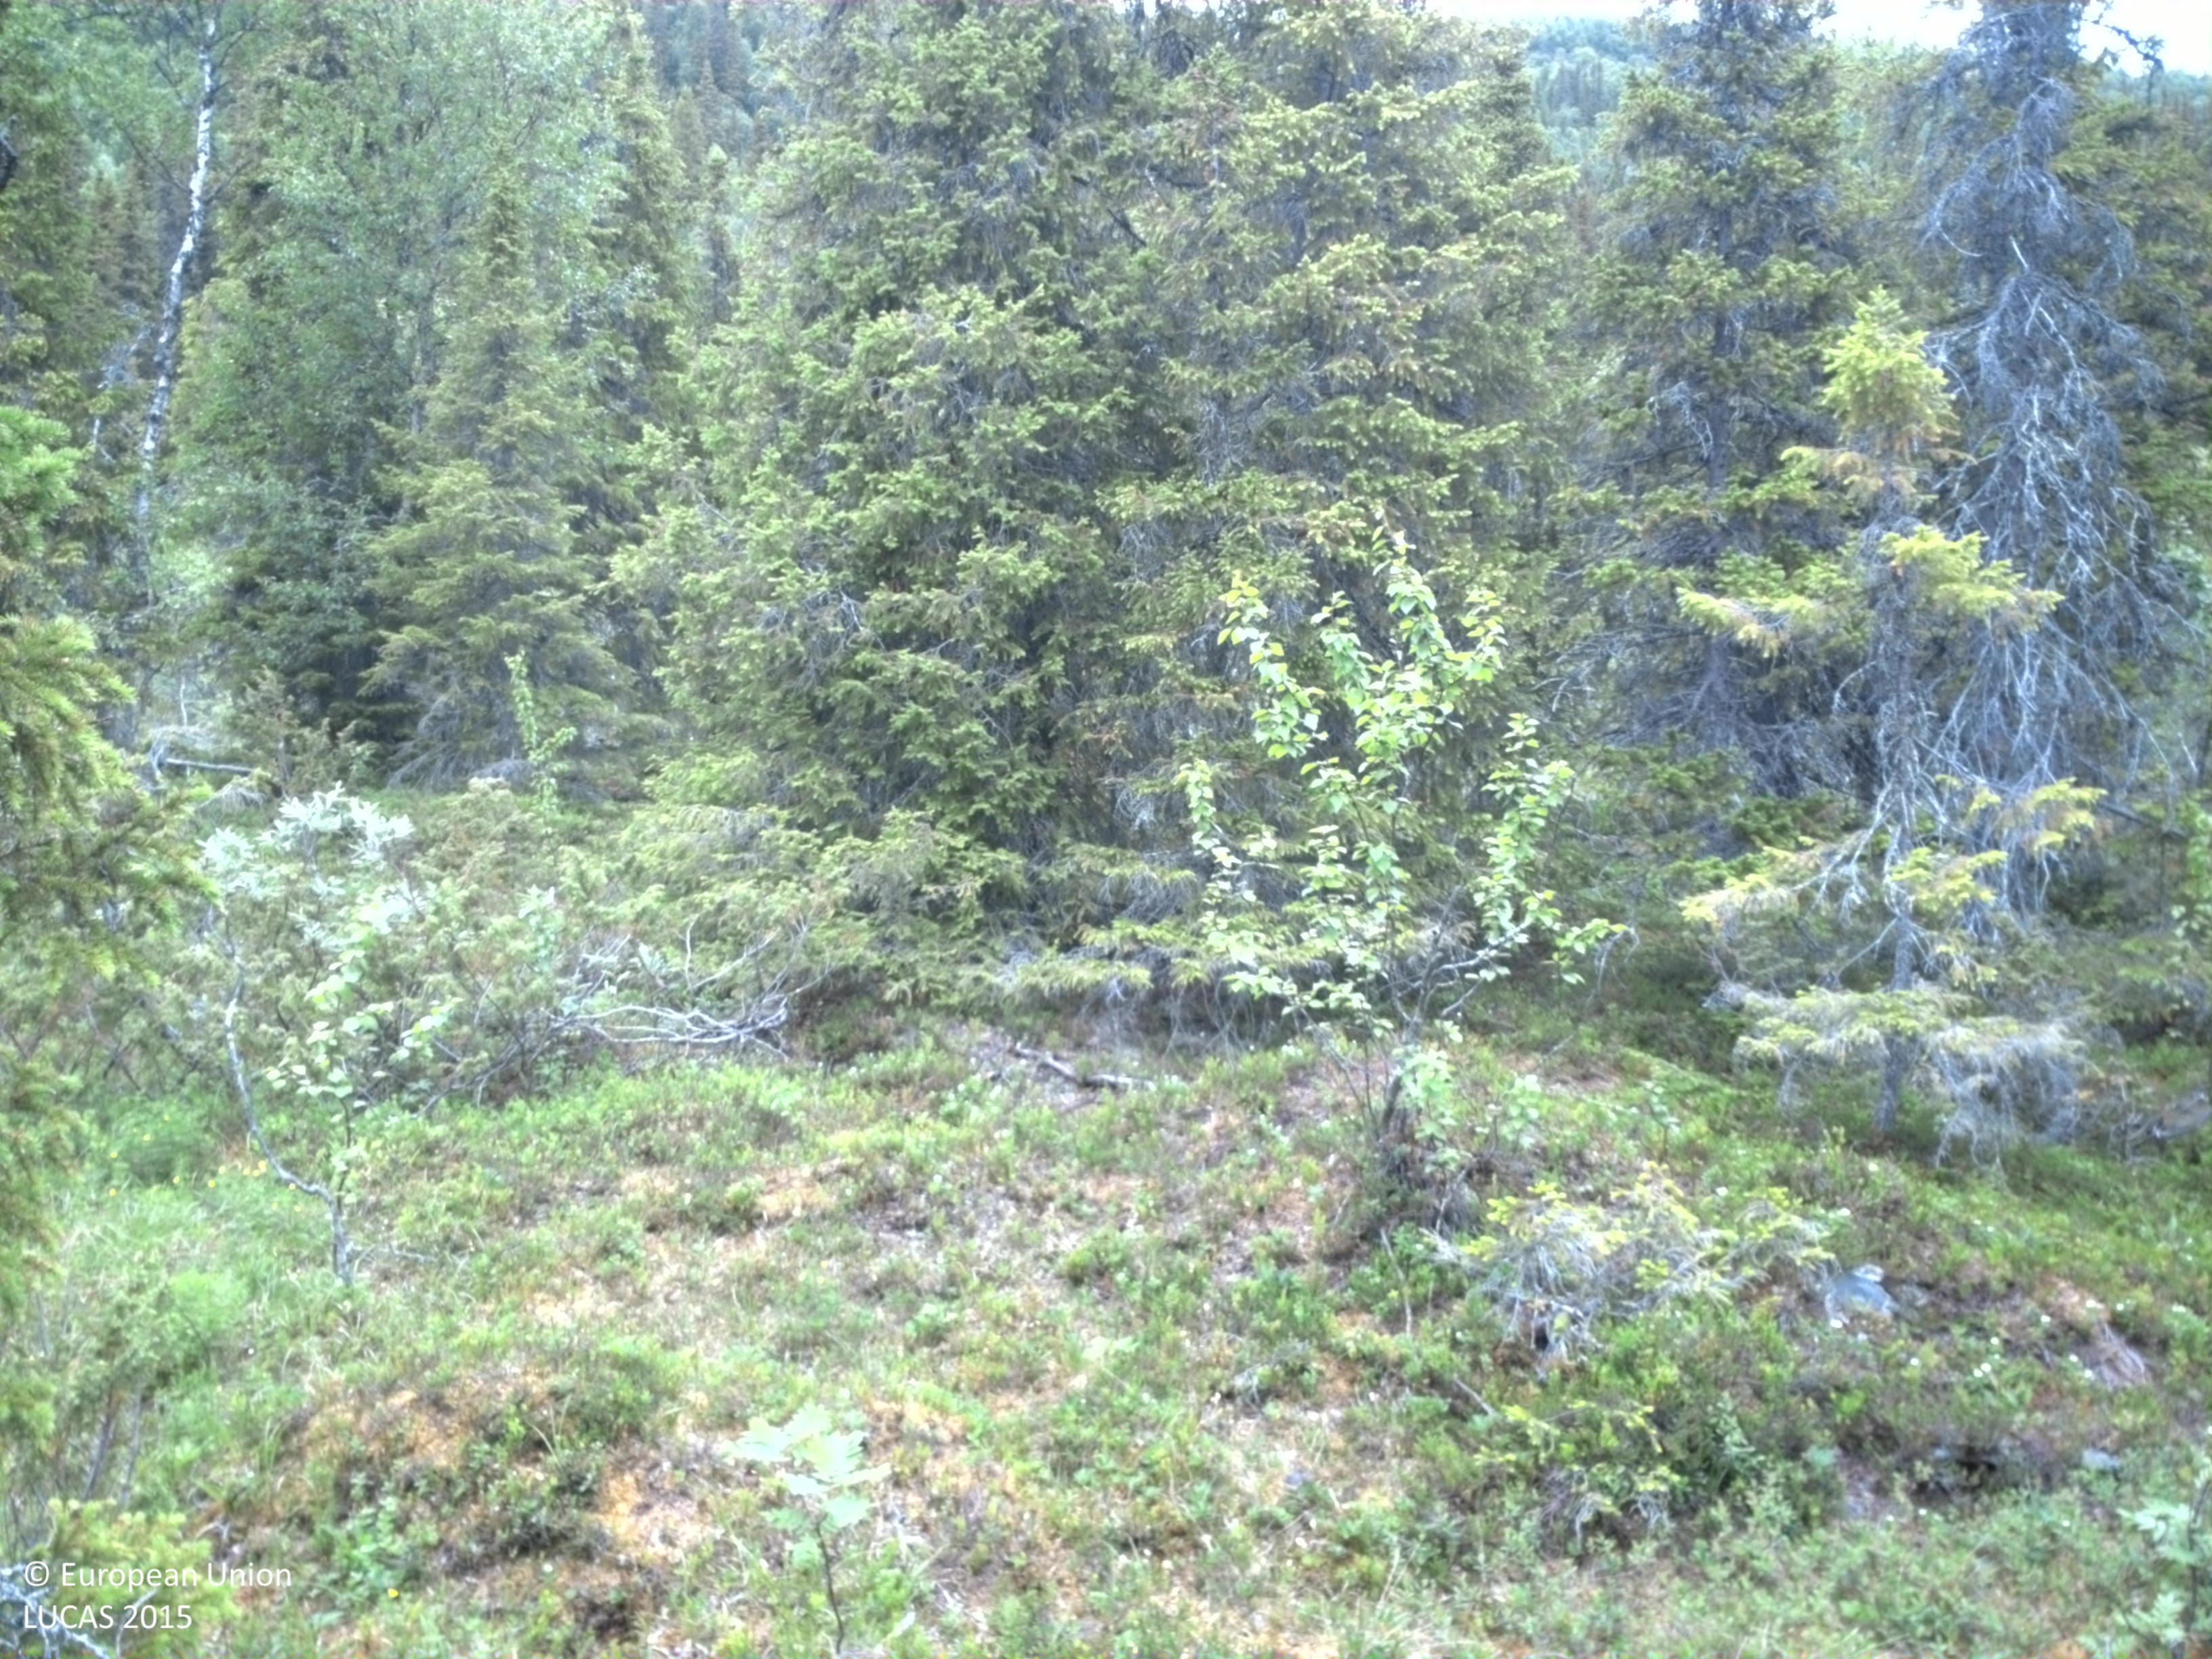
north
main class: Woodland
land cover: Spruce dominated mixed woodland
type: boreal forest
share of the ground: 25 - 50 %
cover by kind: herbaceous plants 35 %, shrubs 30 %, coniferous forest trees 15 %, broadleaved forest trees 10 %, lichens and mosses 10 %
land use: Semi-natural and natural areas not in use
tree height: > 5 m
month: July
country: SE
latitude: 65.6748
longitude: 15.6416
